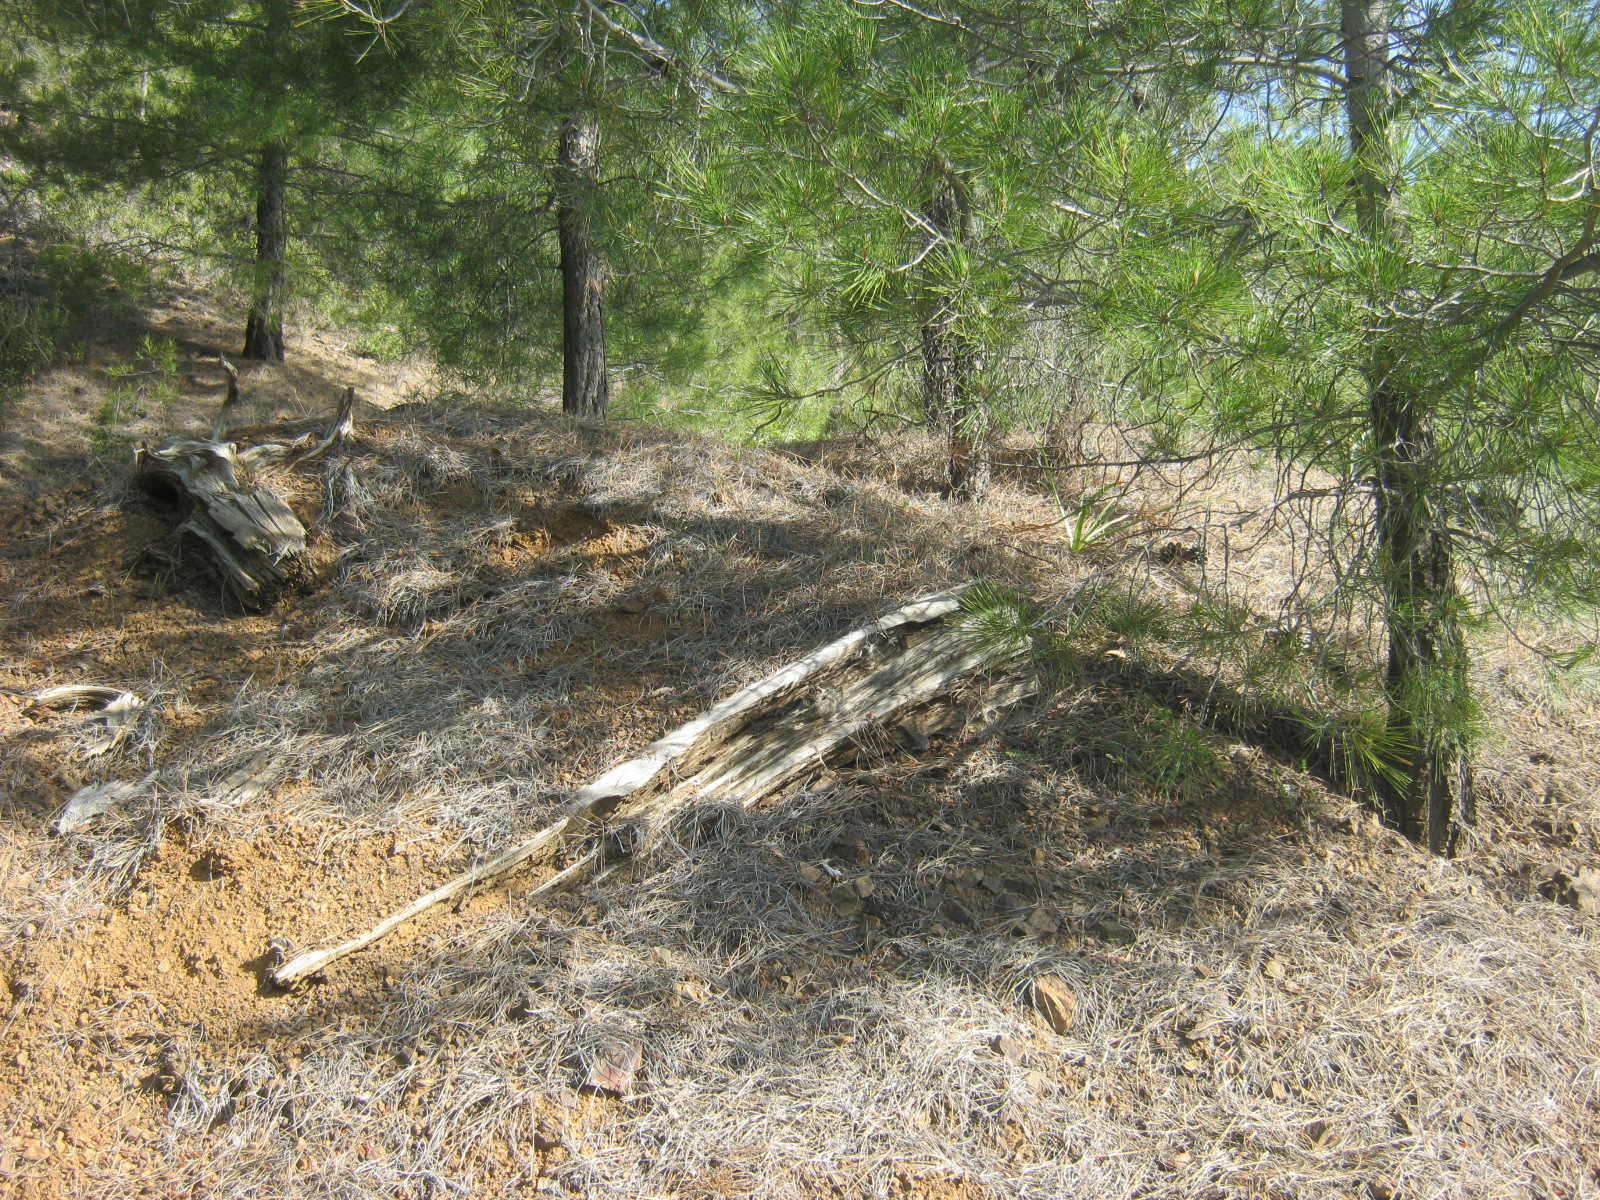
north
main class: Woodland
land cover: Pine dominated coniferous woodland
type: coniferous forest of the mediterranean region
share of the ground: 50 - 75 %
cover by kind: coniferous forest trees 50 %, unconsolidated bare surface 35 %, shrubs 15 %
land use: Forestry
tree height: > 5 m
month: May
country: CY
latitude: 35.0319
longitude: 32.8017
